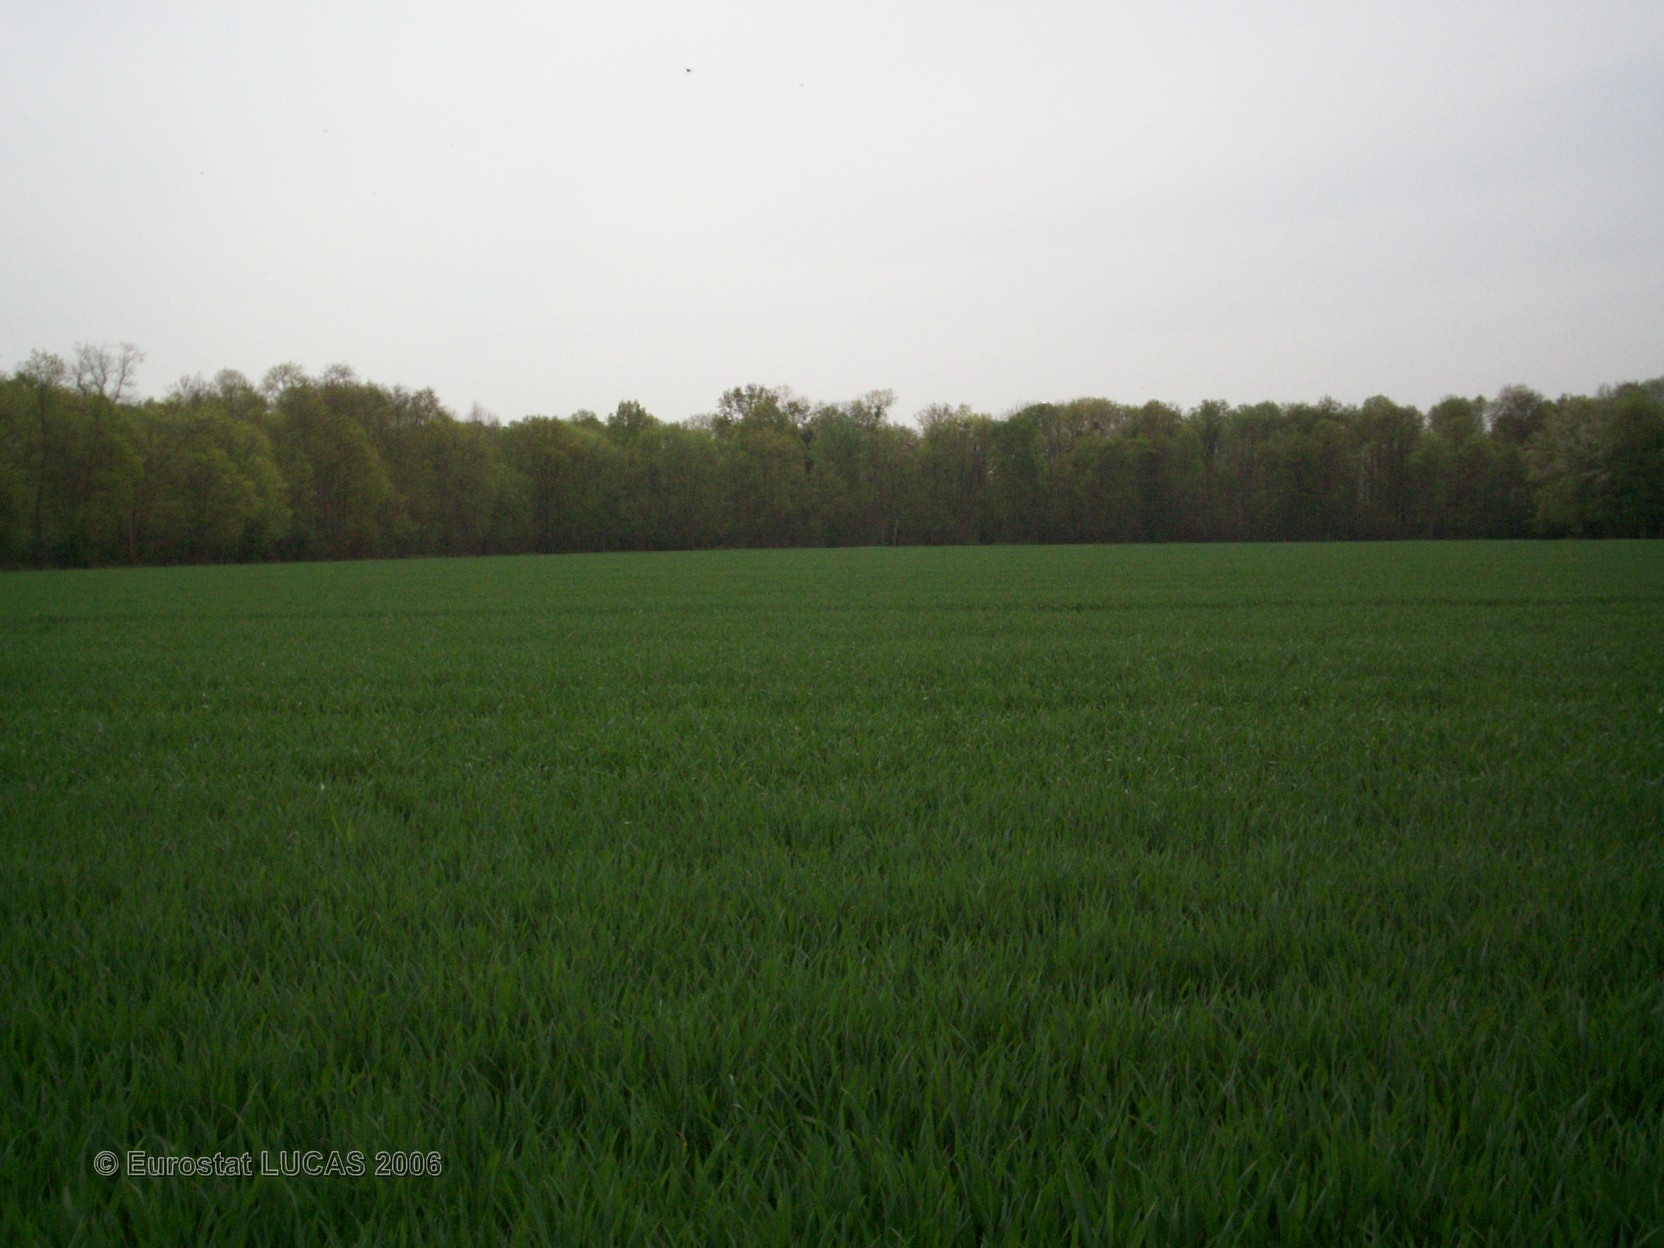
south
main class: Cropland
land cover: Common wheat
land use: Agriculture (excluding fallow land and kitchen gardens)
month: May
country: FR
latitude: 48.6801
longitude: 2.8877
